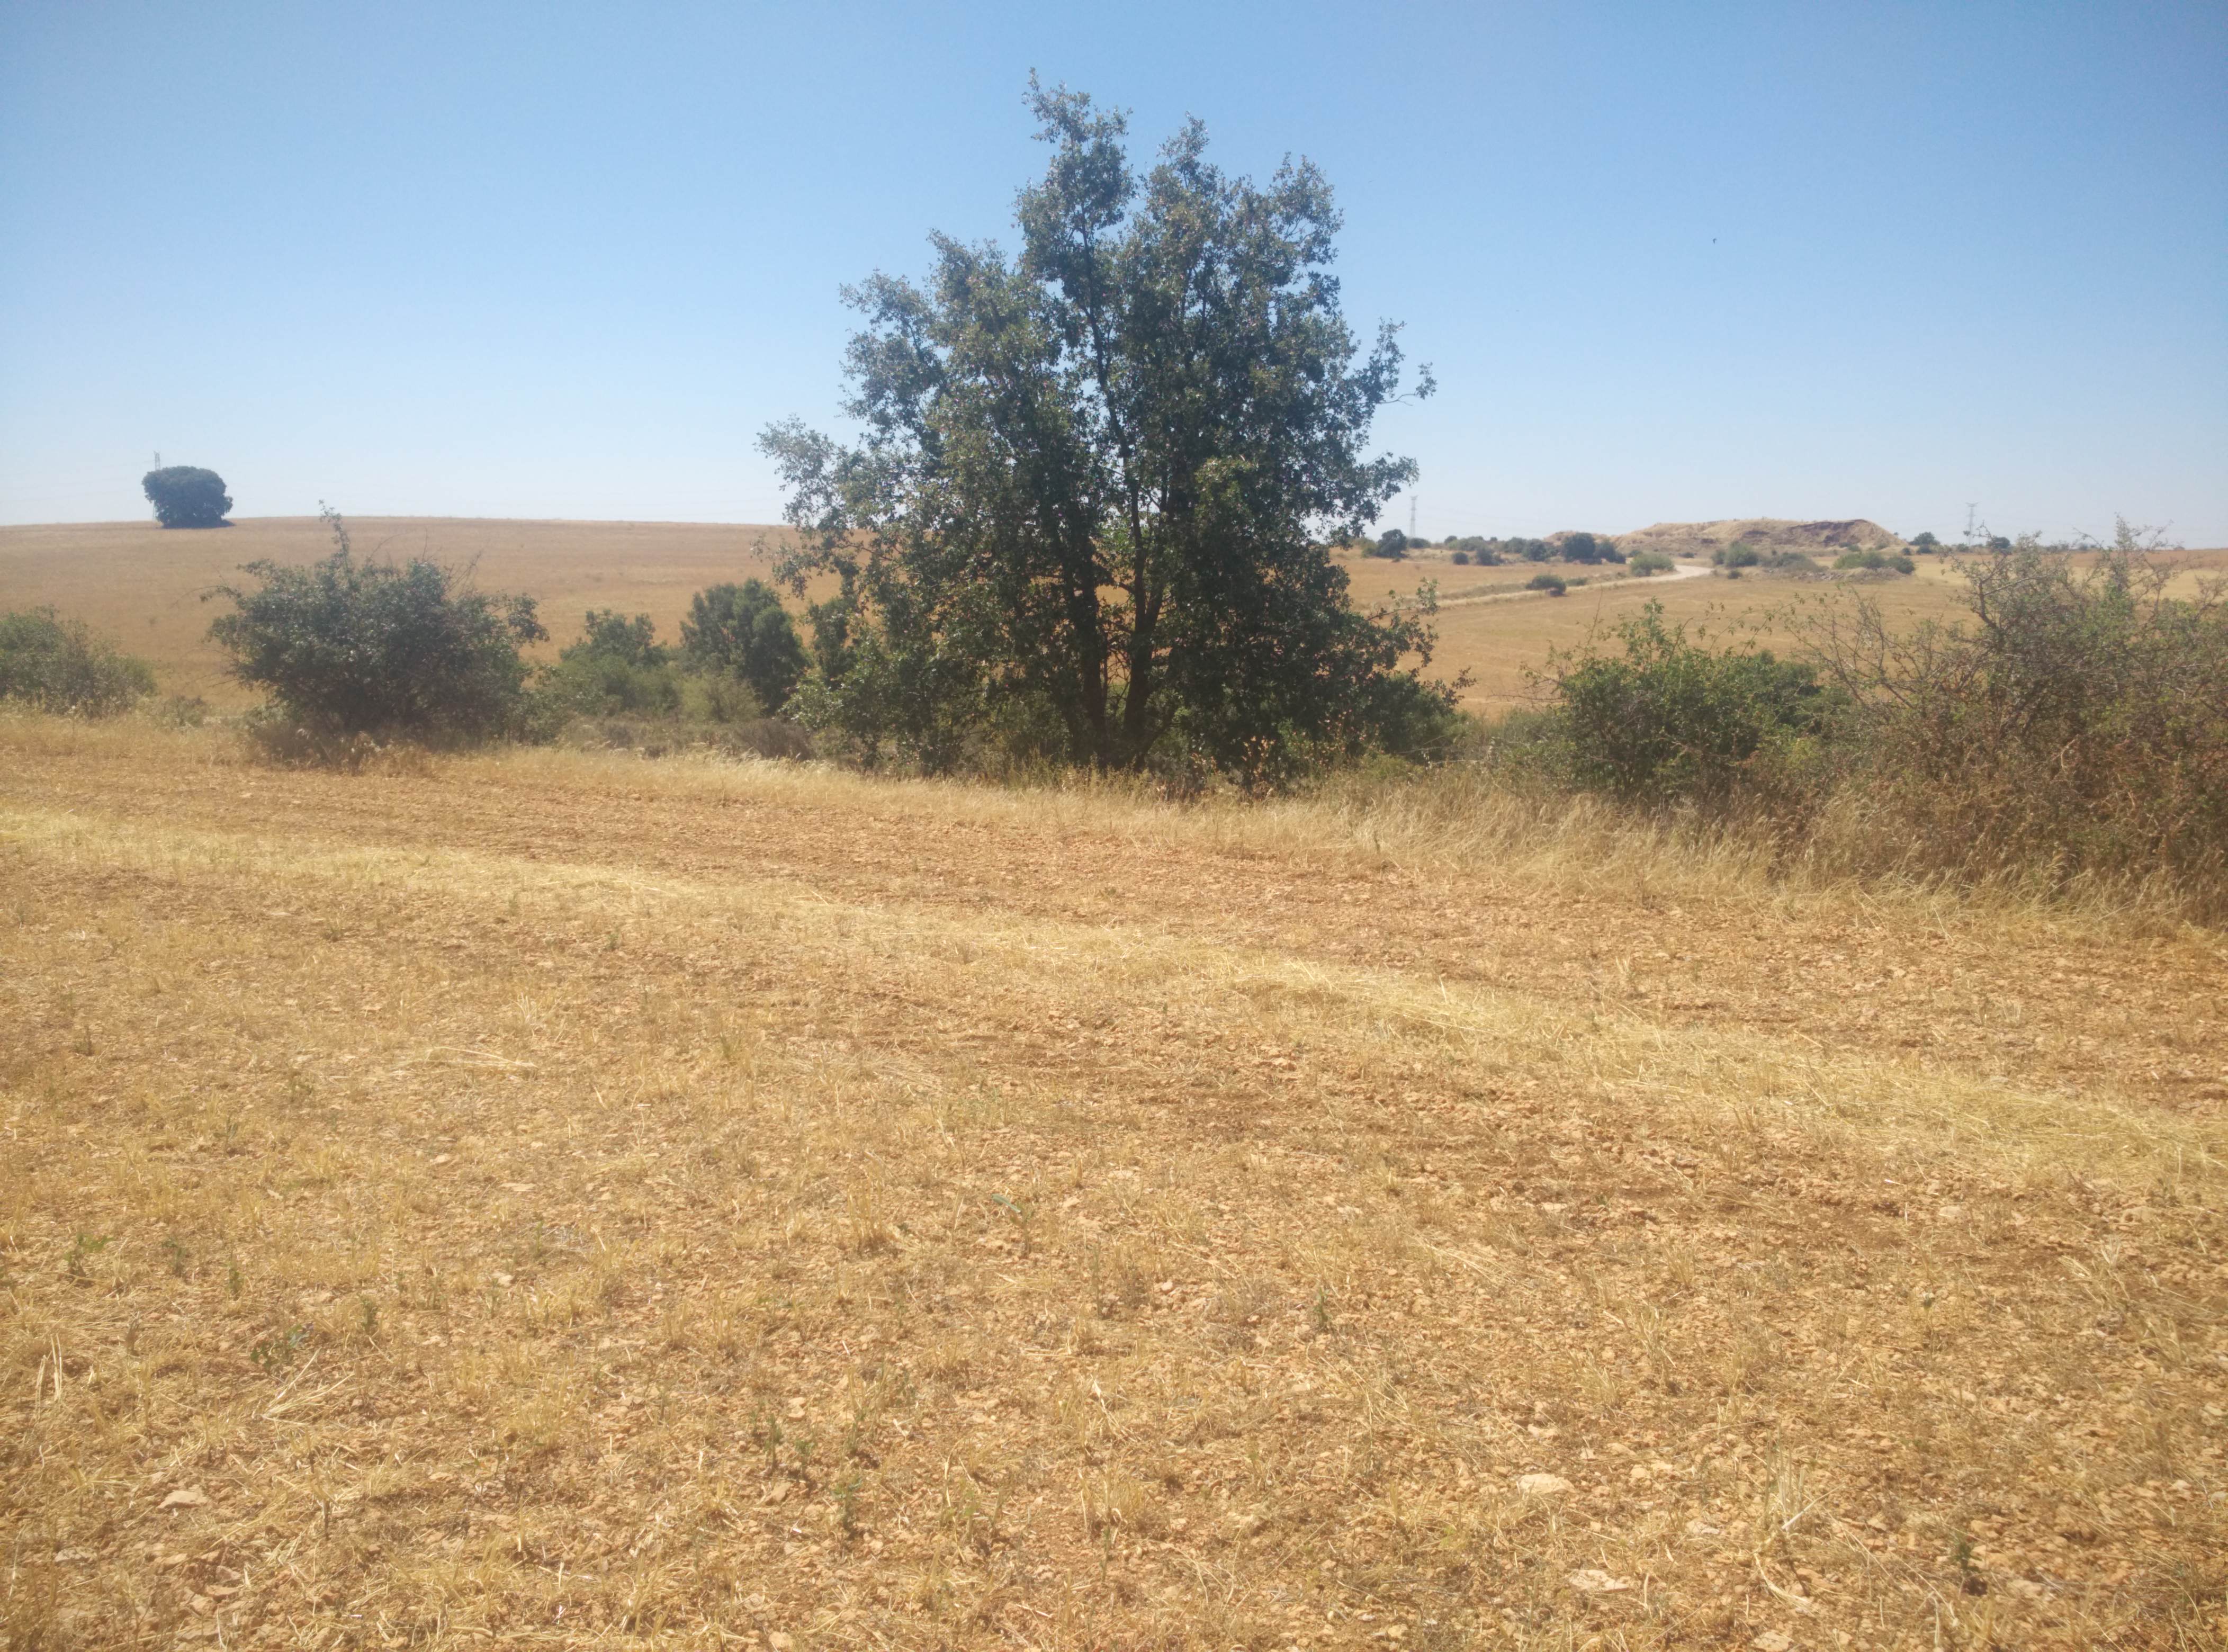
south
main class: Cropland
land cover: Common wheat
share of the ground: < 10 %
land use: Agriculture (excluding fallow land and kitchen gardens)
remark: Harvested field
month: July
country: ES
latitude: 40.6279
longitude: -2.8329
